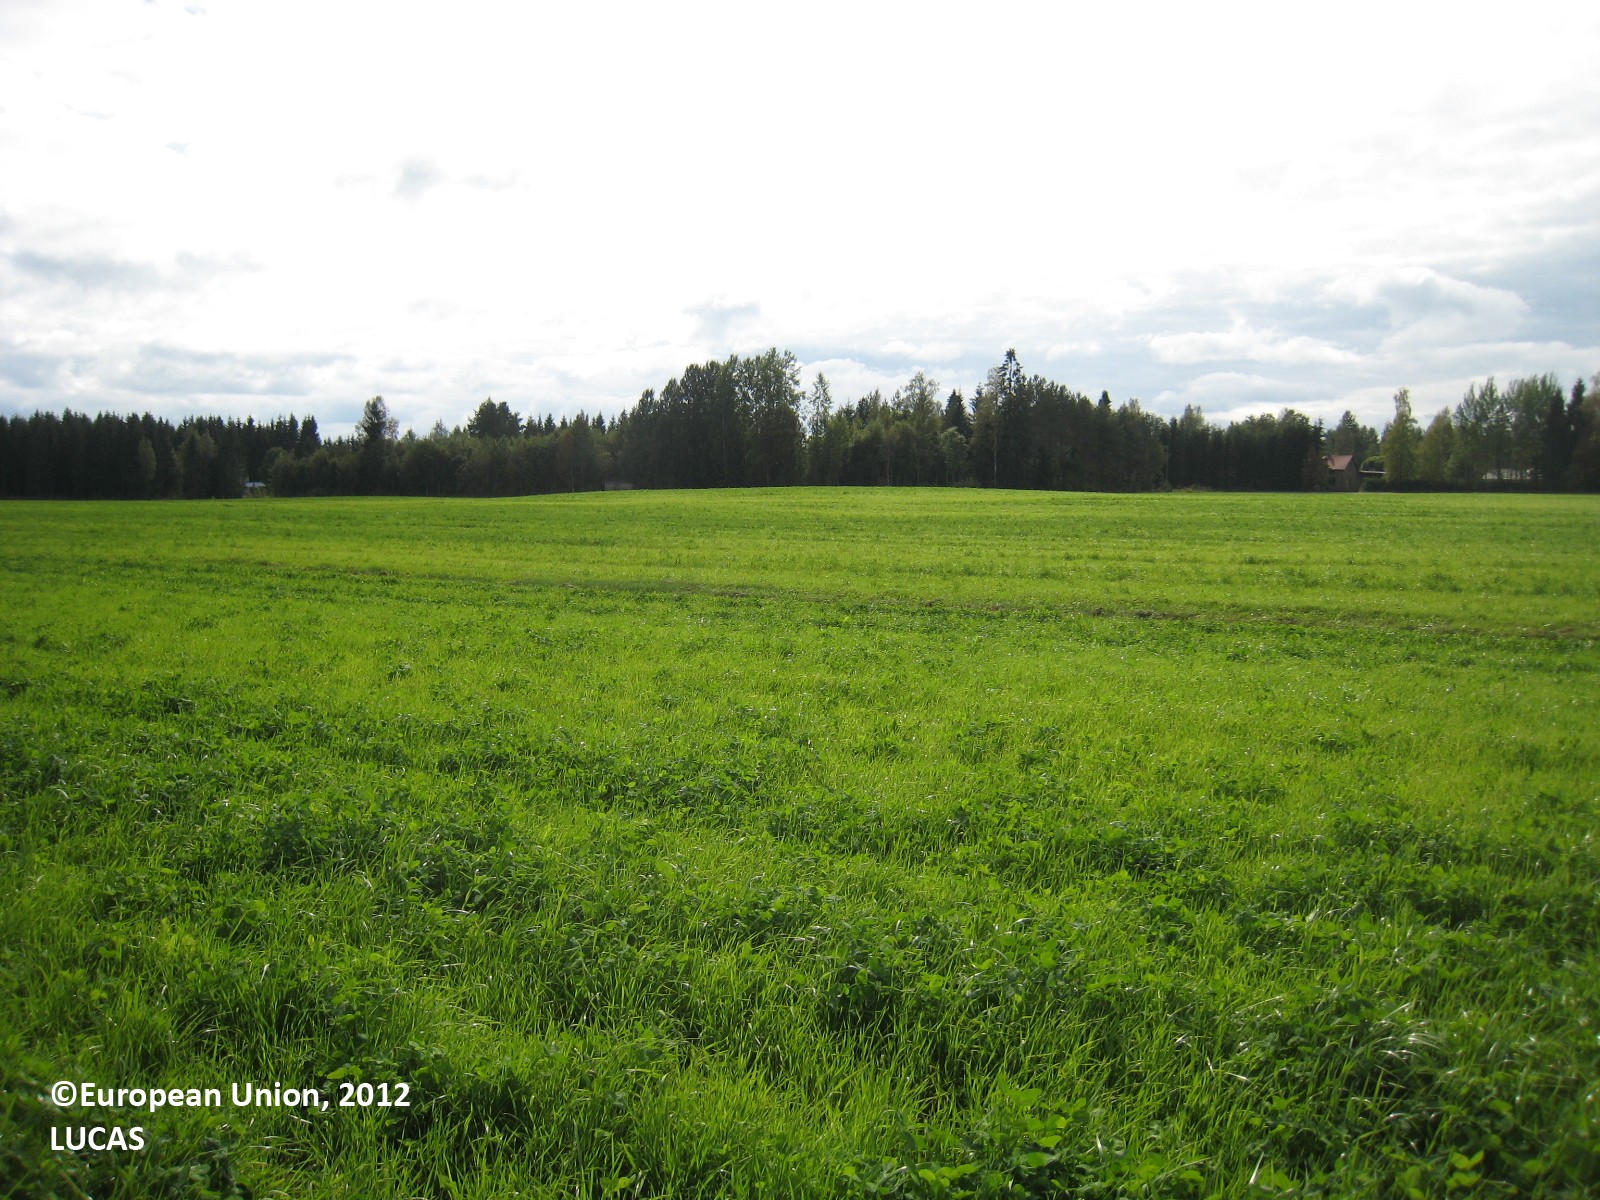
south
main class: Cropland
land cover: Temporary grasslands
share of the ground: > 75 %
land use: Agriculture (excluding fallow land and kitchen gardens)
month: August
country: FI
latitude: 62.2111
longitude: 27.2951
